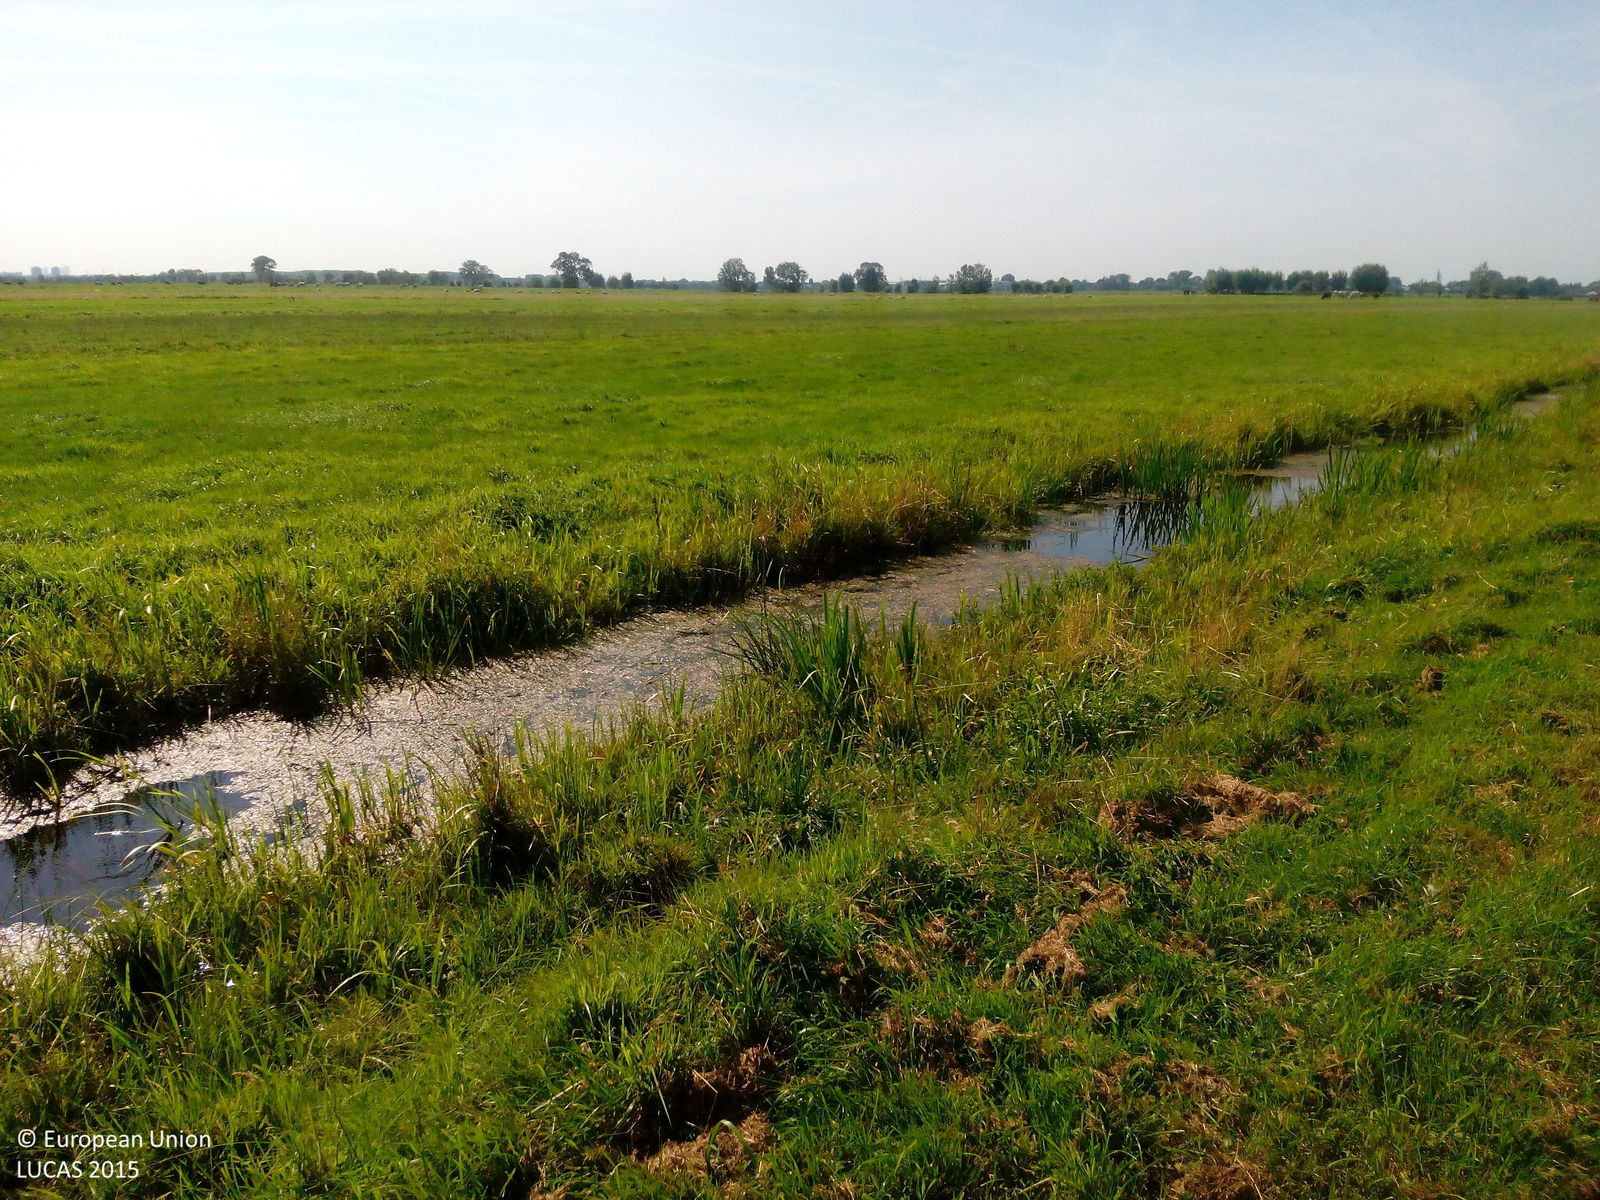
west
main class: Grassland
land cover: Grassland without tree/shrub cover
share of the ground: > 75 %
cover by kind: herbaceous plants 90 %, unconsolidated bare surface 10 %
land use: Agriculture (excluding fallow land and kitchen gardens)
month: August
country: NL
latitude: 51.9702
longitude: 4.6834
